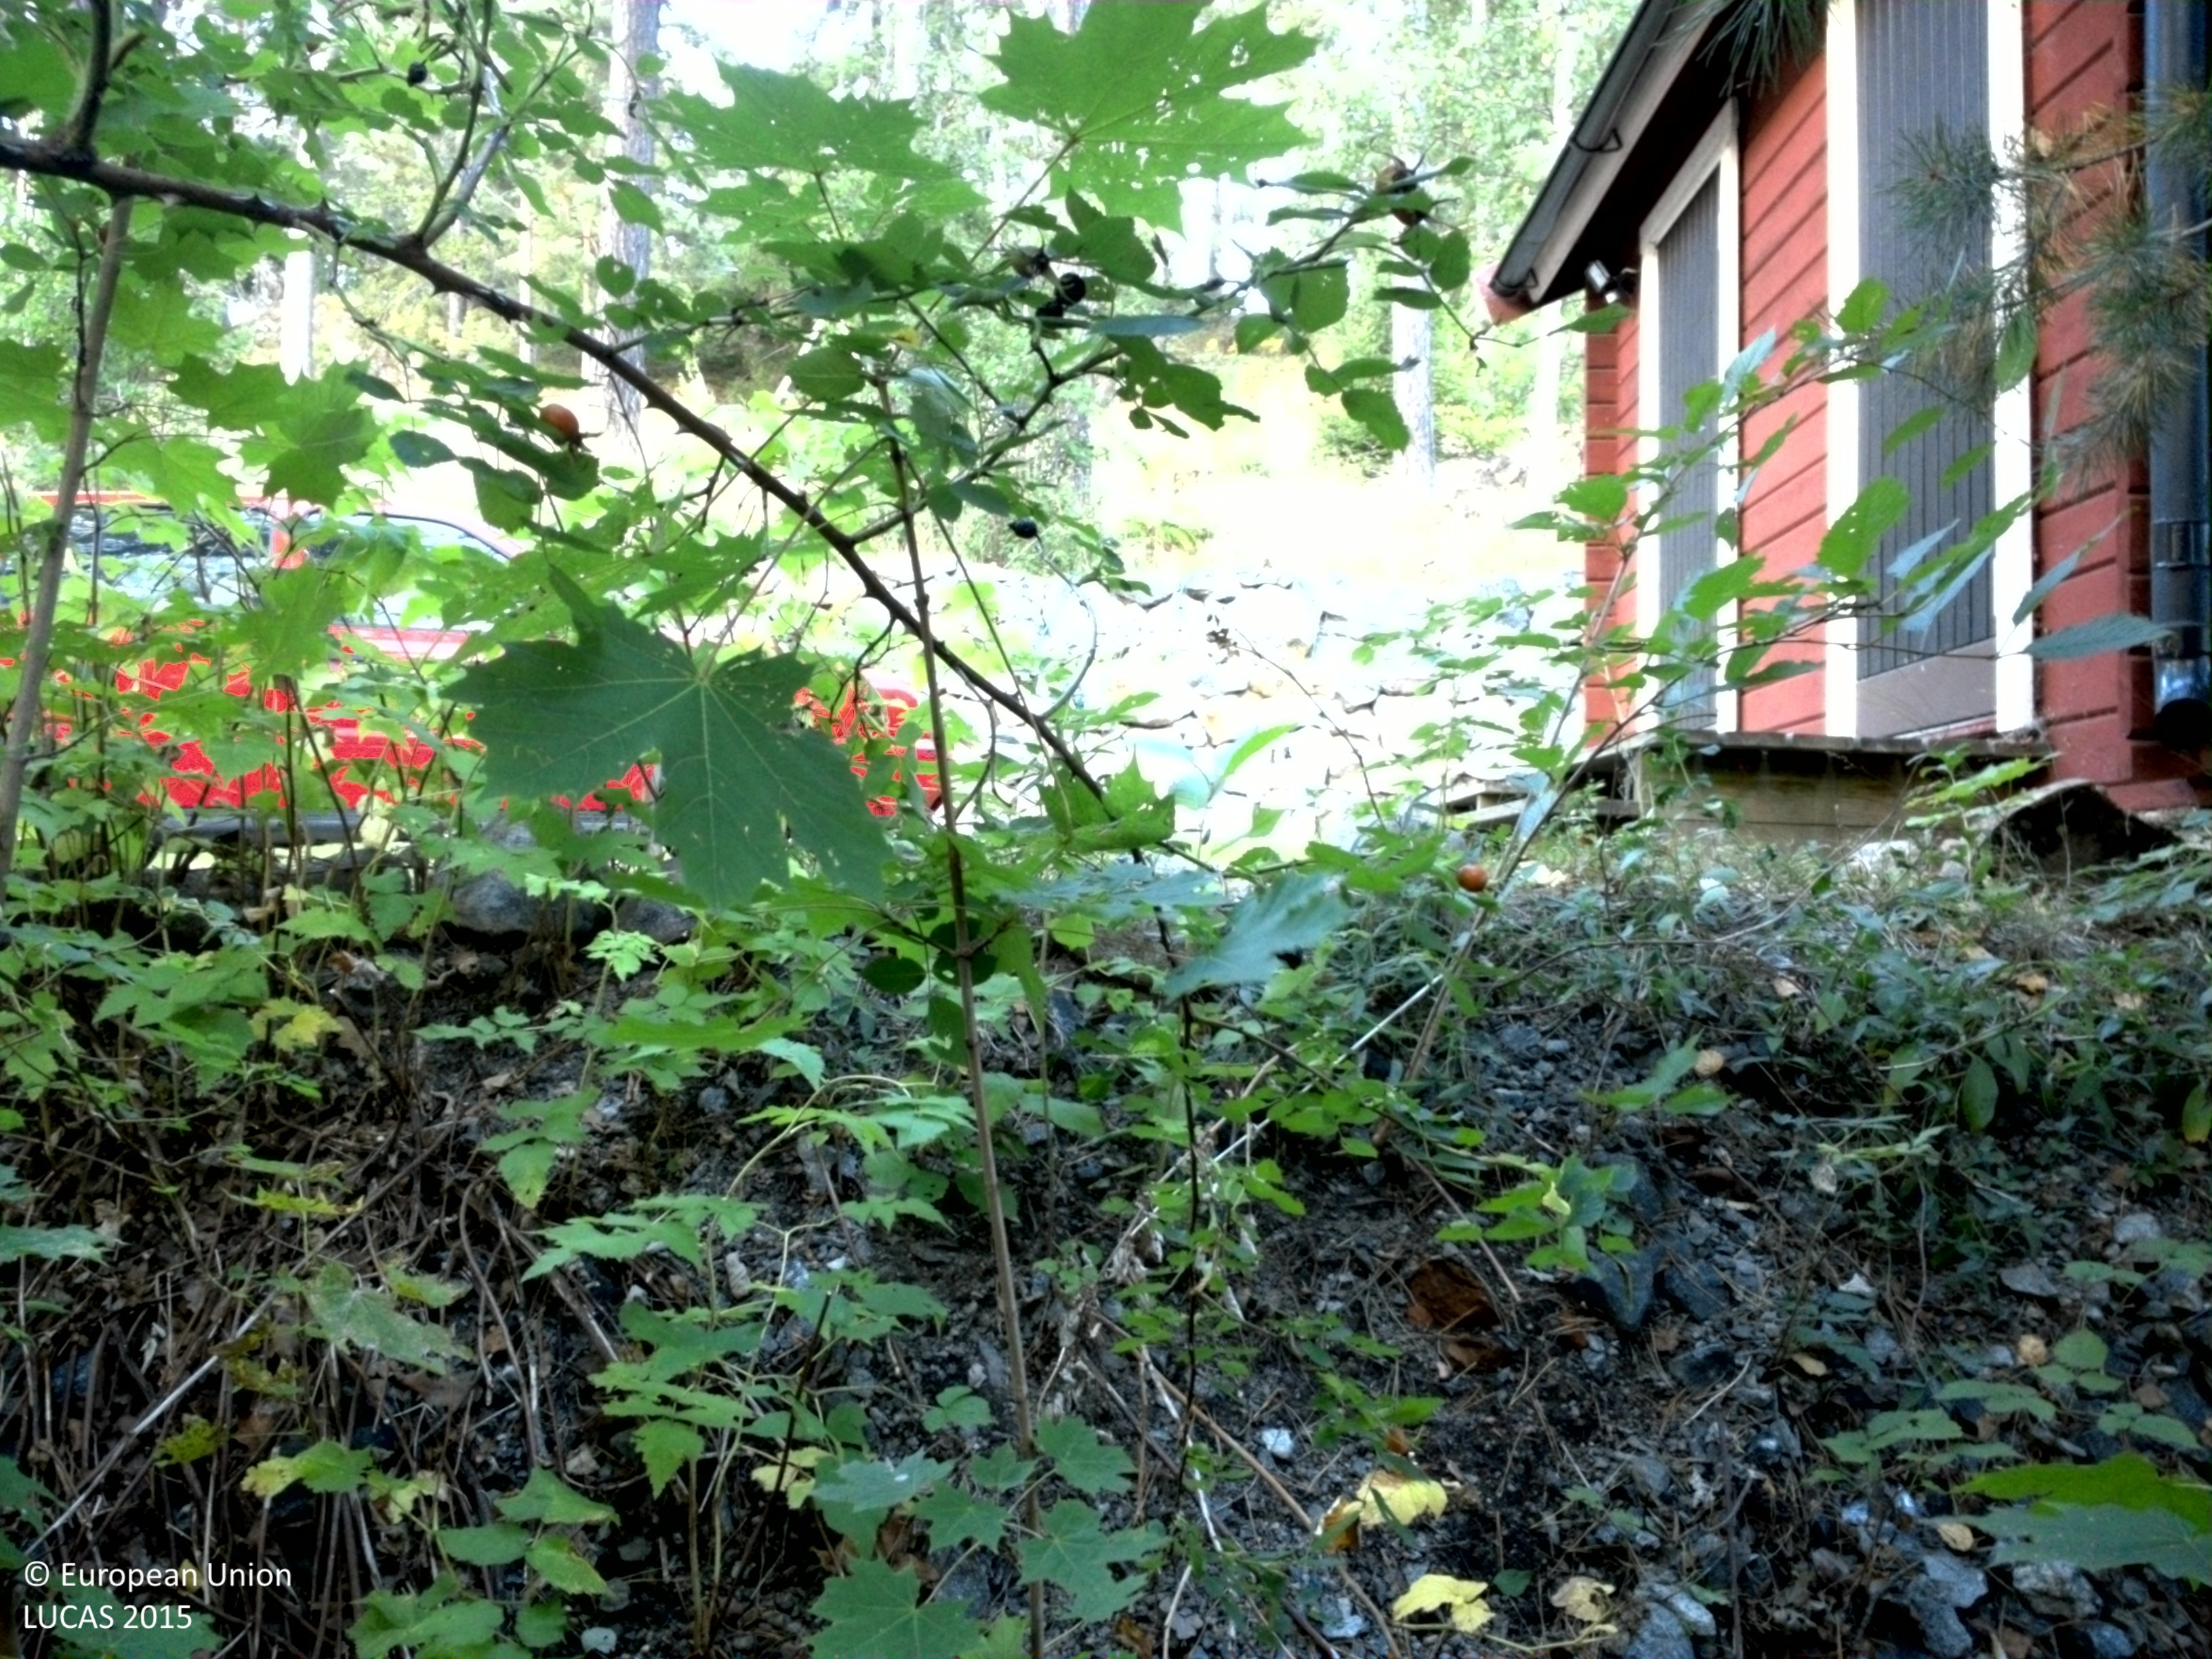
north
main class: Woodland
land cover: Broadleaved woodland
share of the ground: 50 - 75 %
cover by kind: broadleaved forest trees 60 %, herbaceous plants 40 %
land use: Semi-natural and natural areas not in use
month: September
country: SE
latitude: 59.2868
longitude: 18.5501
